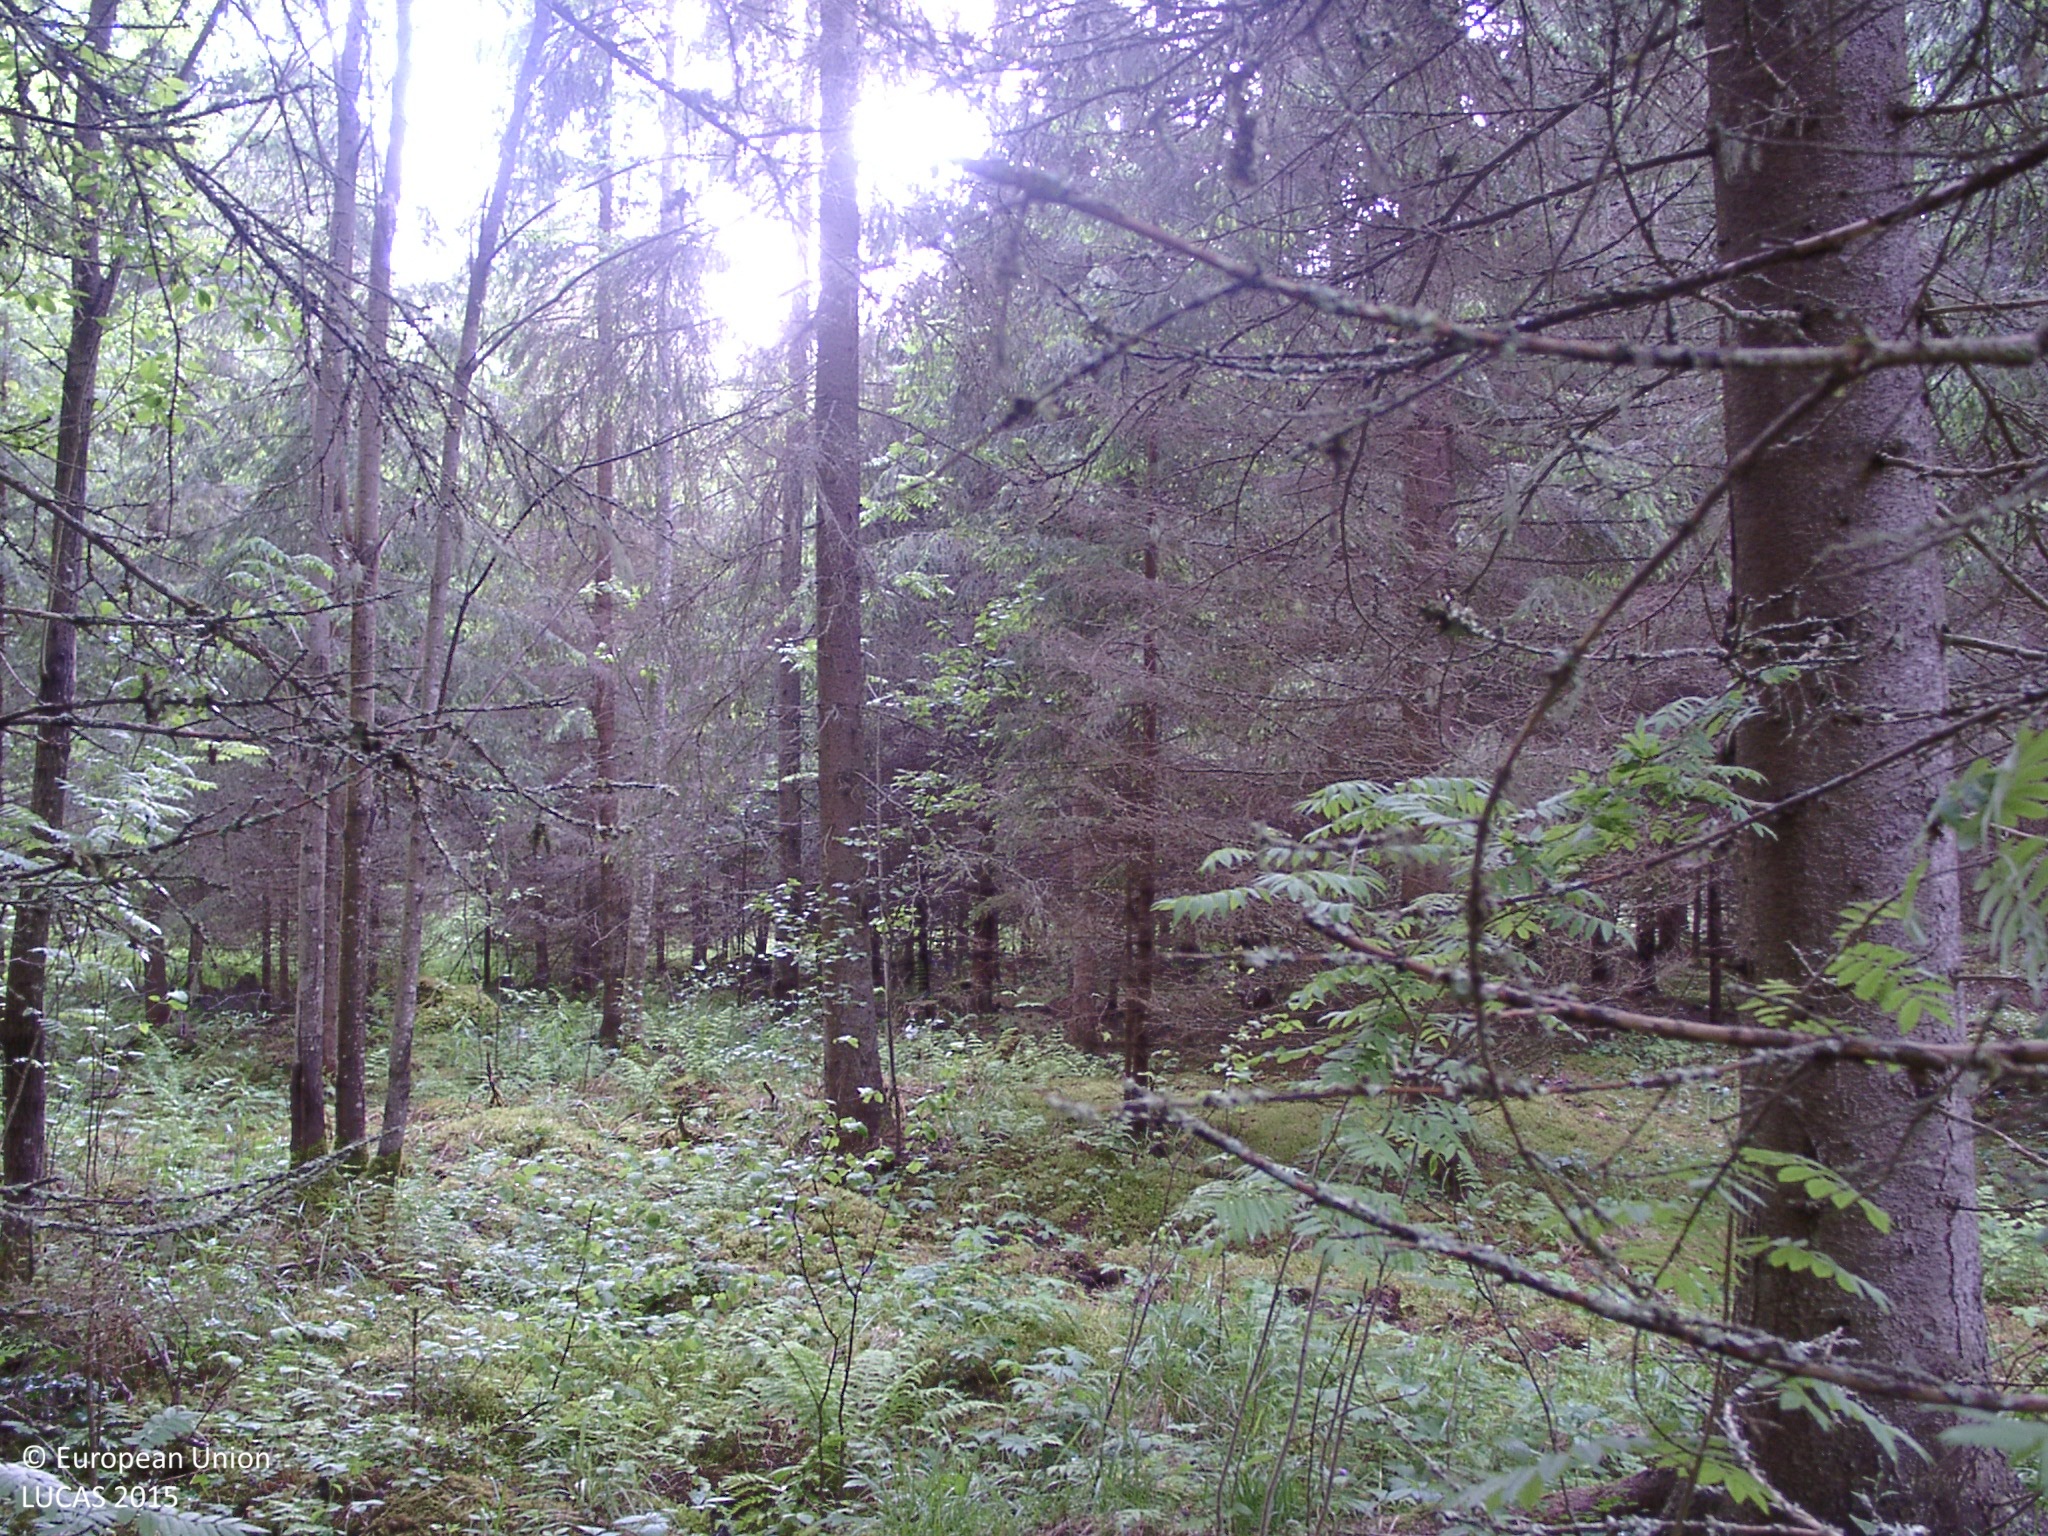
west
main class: Woodland
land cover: Spruce dominated coniferous woodland
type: boreal forest
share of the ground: 50 - 75 %
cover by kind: coniferous forest trees 60 %, herbaceous plants 15 %, lichens and mosses 15 %, broadleaved forest trees 10 %
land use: Forestry
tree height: > 5 m
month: June
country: FI
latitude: 61.5930
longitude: 24.8595
